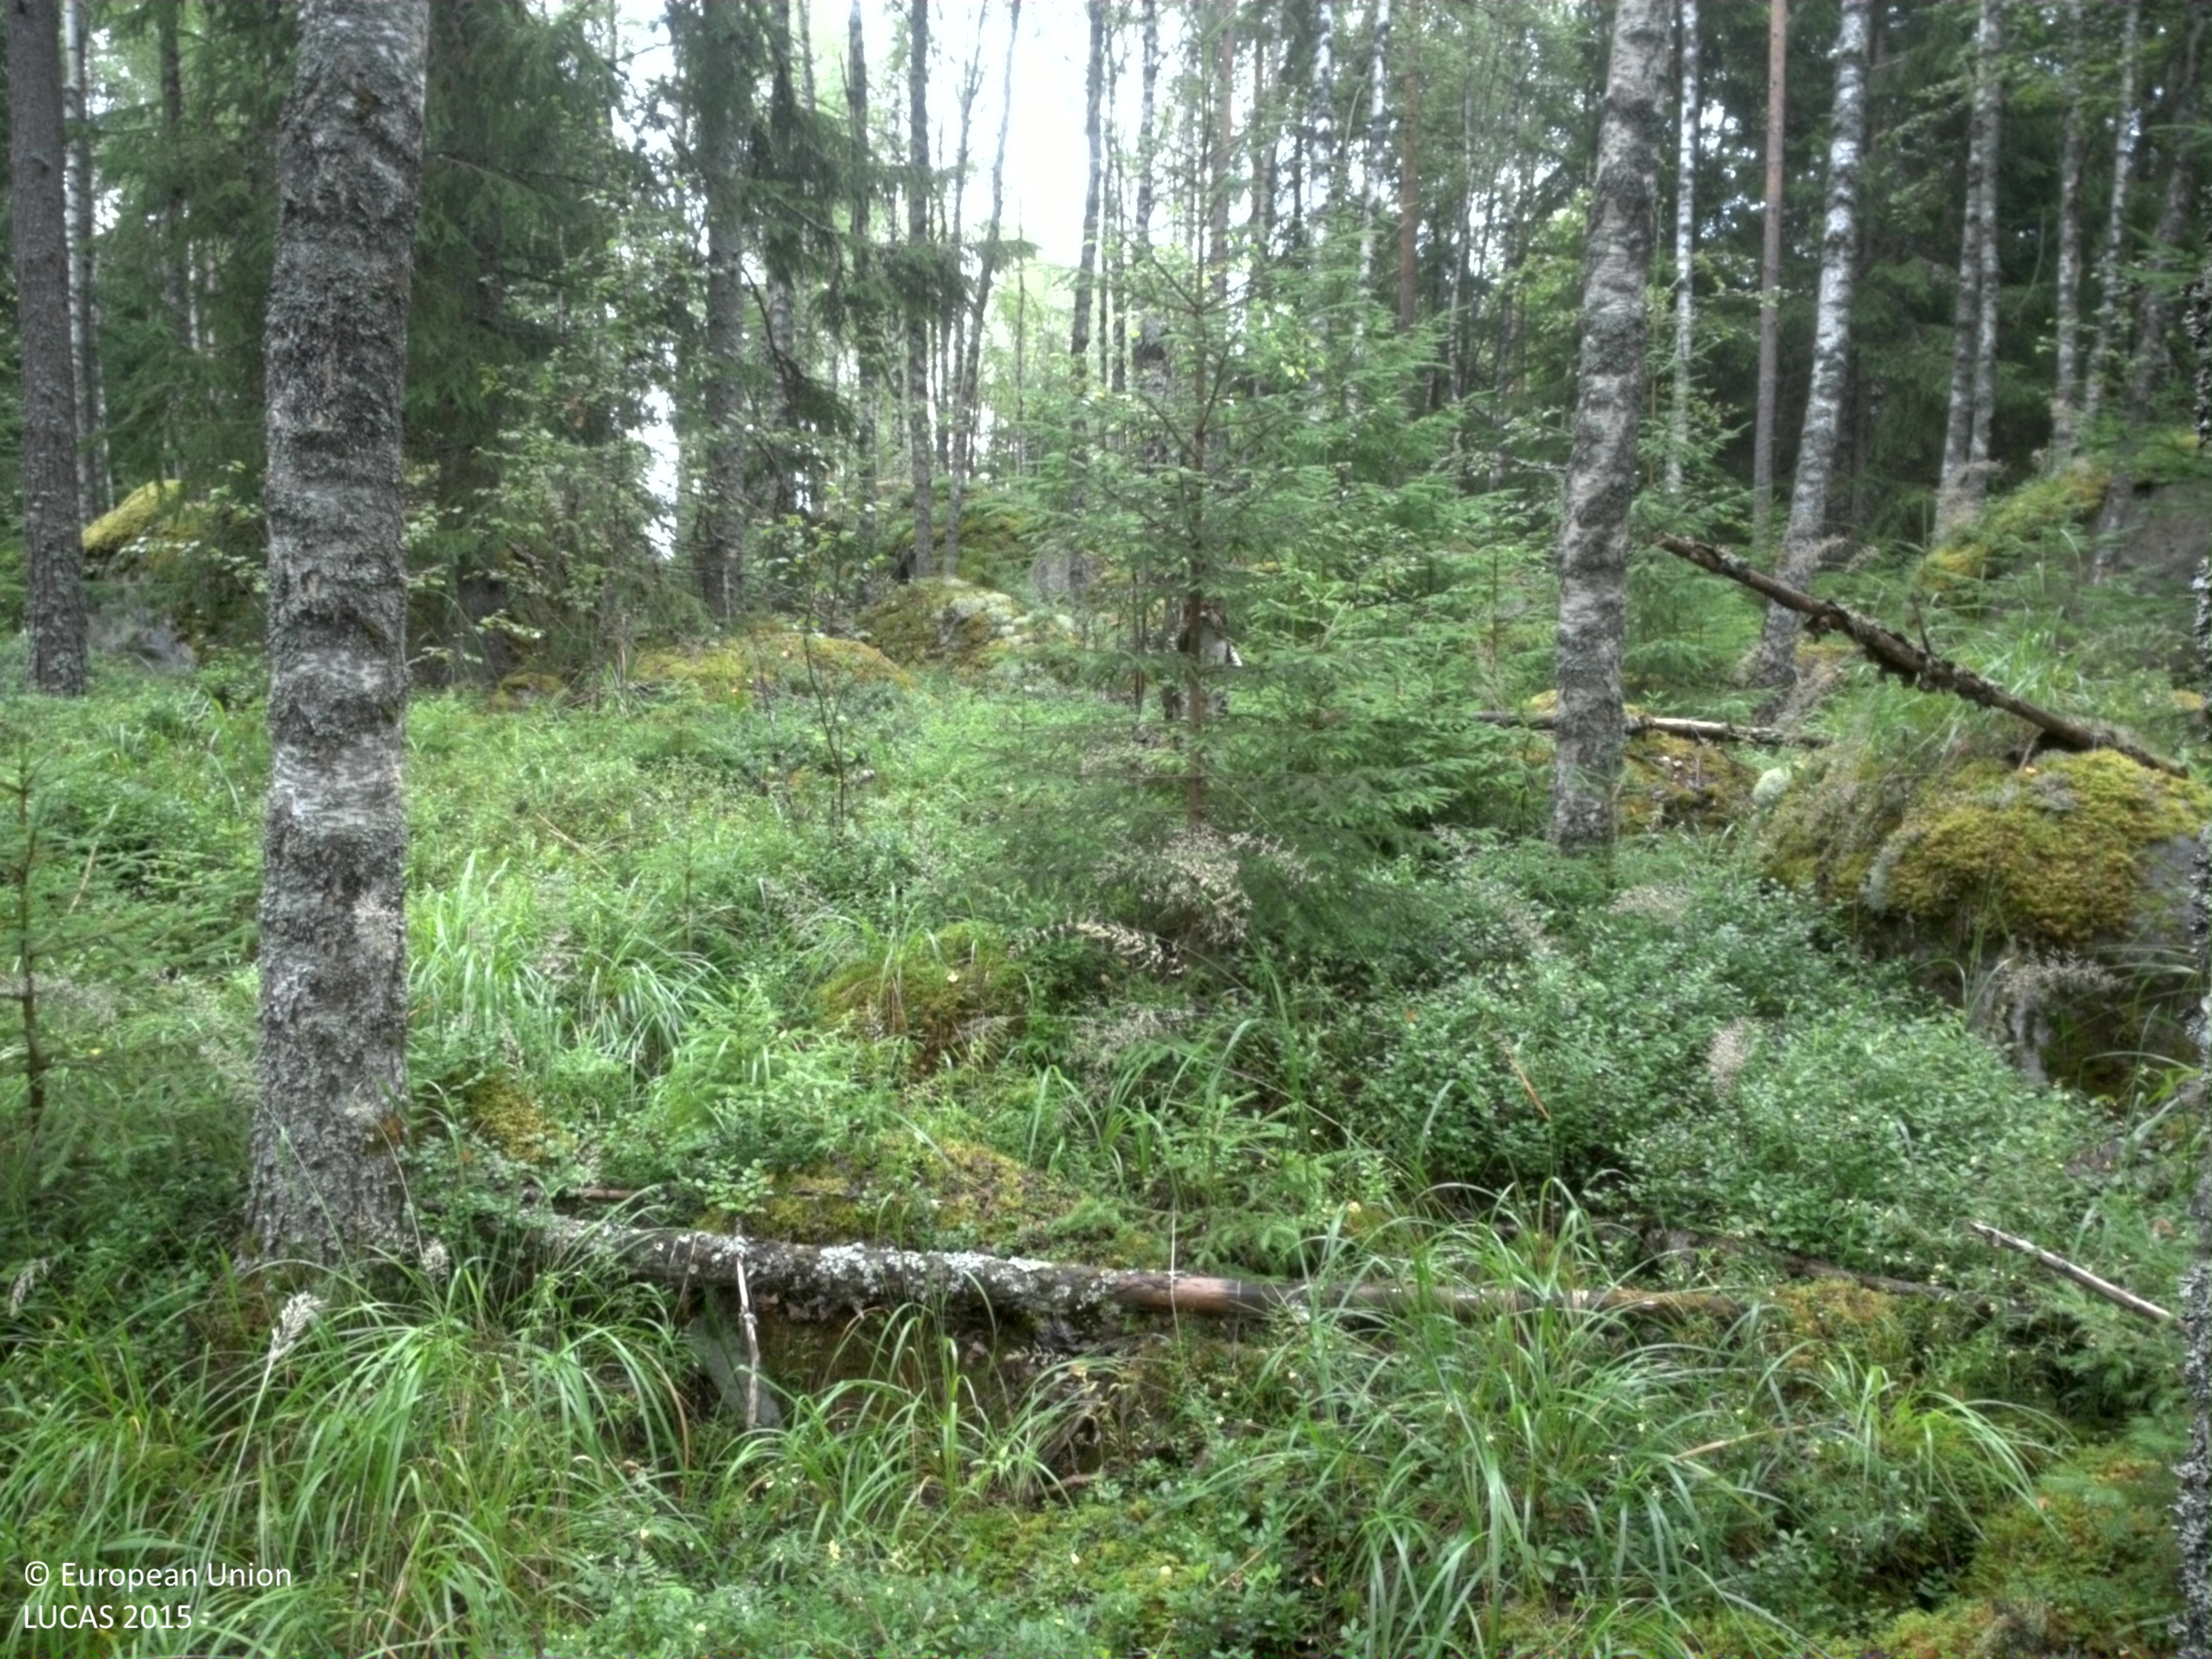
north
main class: Woodland
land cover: Other mixed woodland
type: boreal forest
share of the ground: > 75 %
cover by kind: broadleaved forest trees 45 %, coniferous forest trees 30 %, herbaceous plants 15 %, shrubs 5 %, lichens and mosses 5 %
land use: Forestry
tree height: > 5 m
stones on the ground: > 50 %
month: July
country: SE
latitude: 59.6855
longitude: 14.2002
